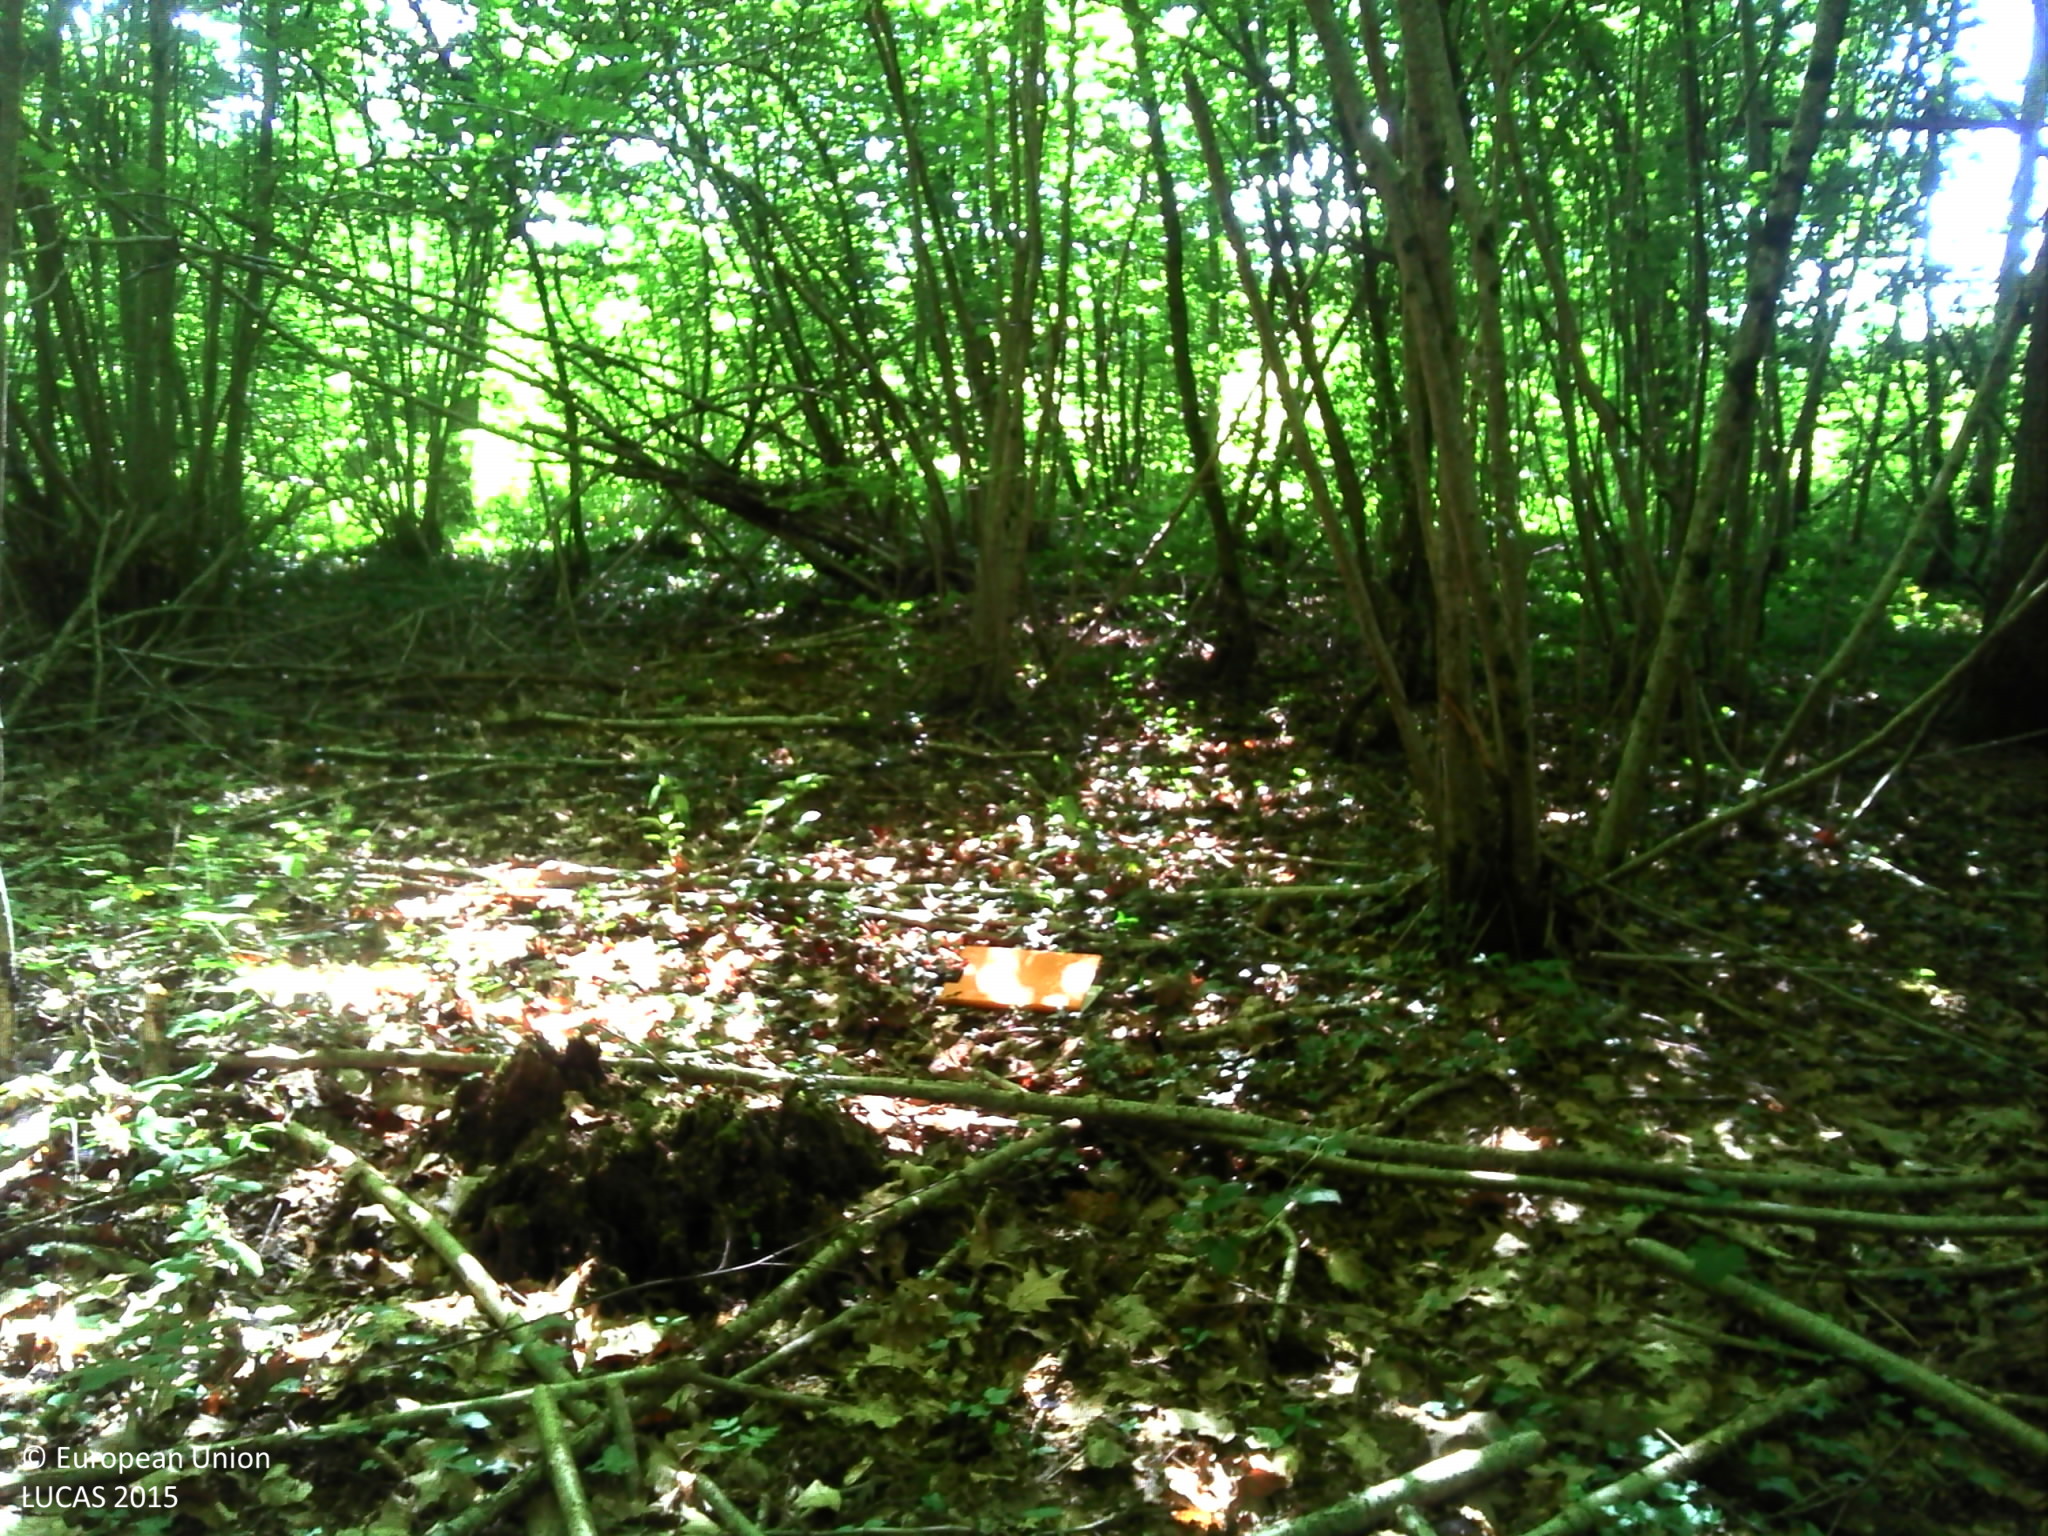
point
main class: Woodland
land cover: Broadleaved woodland
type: beech forest
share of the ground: > 75 %
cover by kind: broadleaved forest trees 90 %, shrubs 5 %, herbaceous plants 5 %
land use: Forestry
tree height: > 5 m
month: June
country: FR
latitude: 47.5073
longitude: 6.1378
